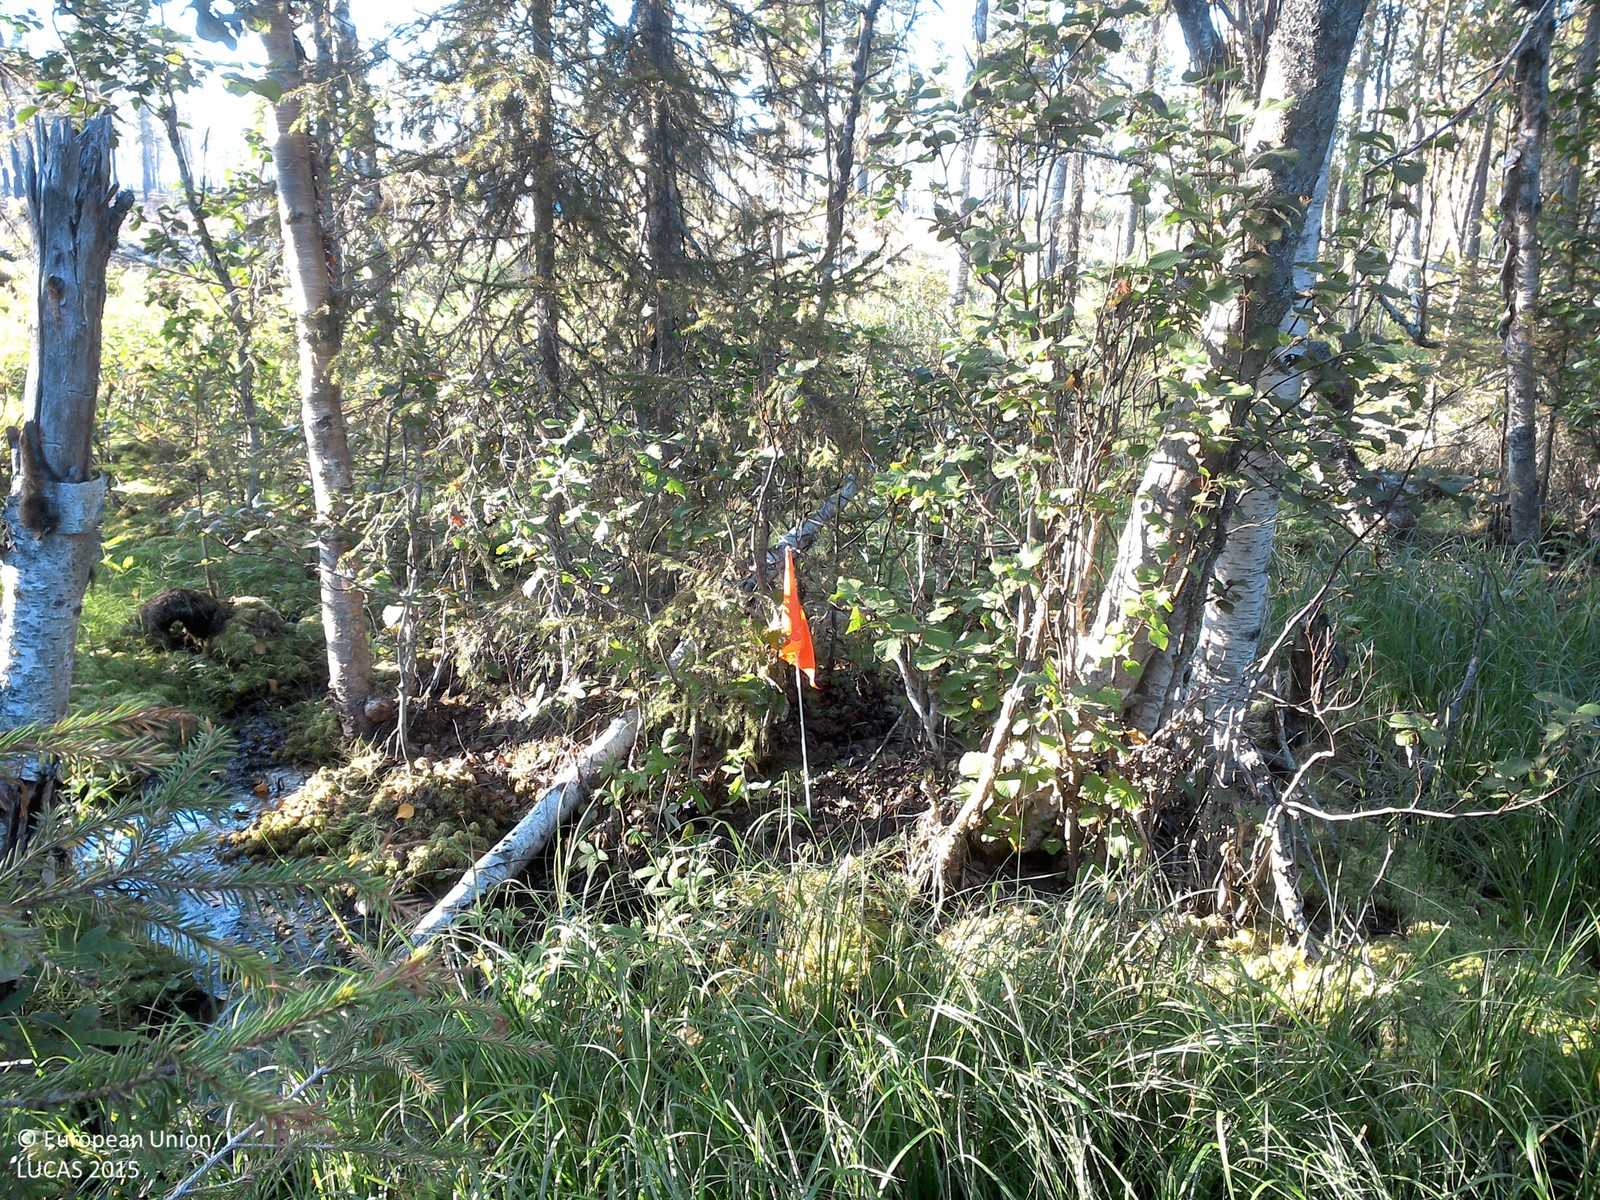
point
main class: Woodland
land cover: Other mixed woodland
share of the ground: 25 - 50 %
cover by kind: herbaceous plants 40 %, broadleaved forest trees 25 %, coniferous forest trees 15 %, lichens and mosses 15 %, shrubs 5 %
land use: Forestry
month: August
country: SE
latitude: 67.1313
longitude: 22.5305
